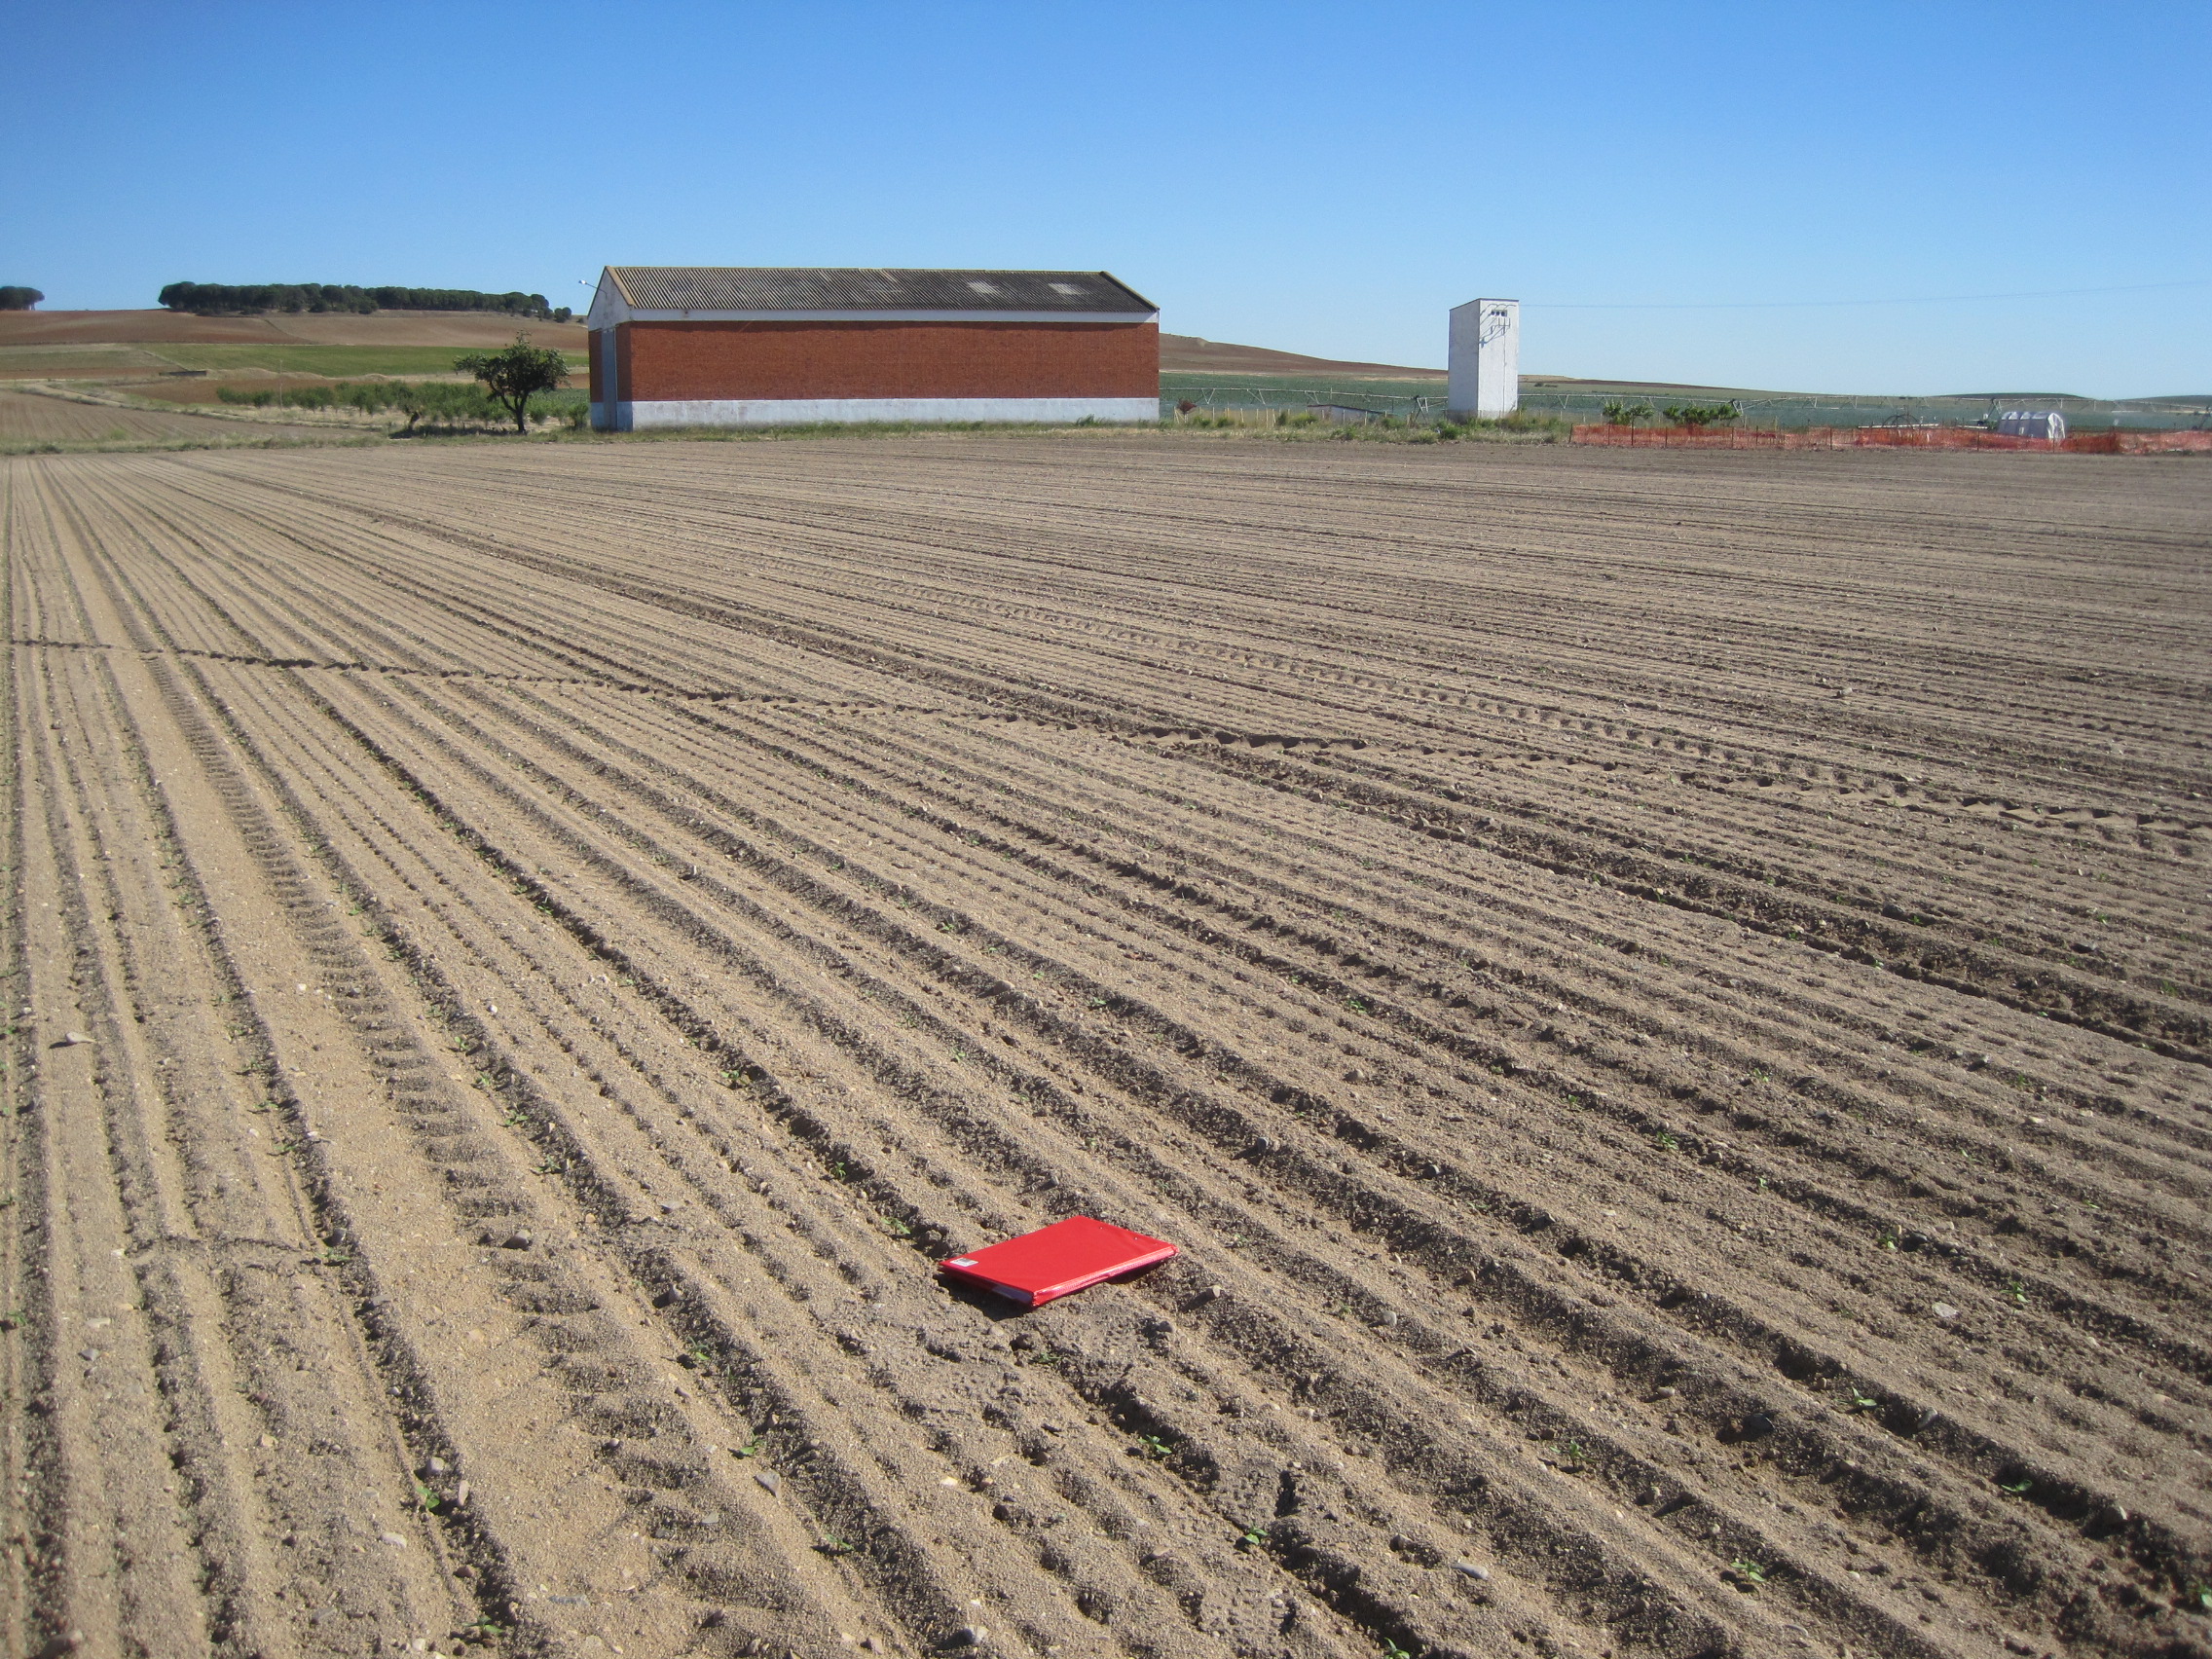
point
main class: Cropland
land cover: Sunflower
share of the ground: < 10 %
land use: Agriculture (excluding fallow land and kitchen gardens)
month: May
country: ES
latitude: 41.3288
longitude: -5.1145
